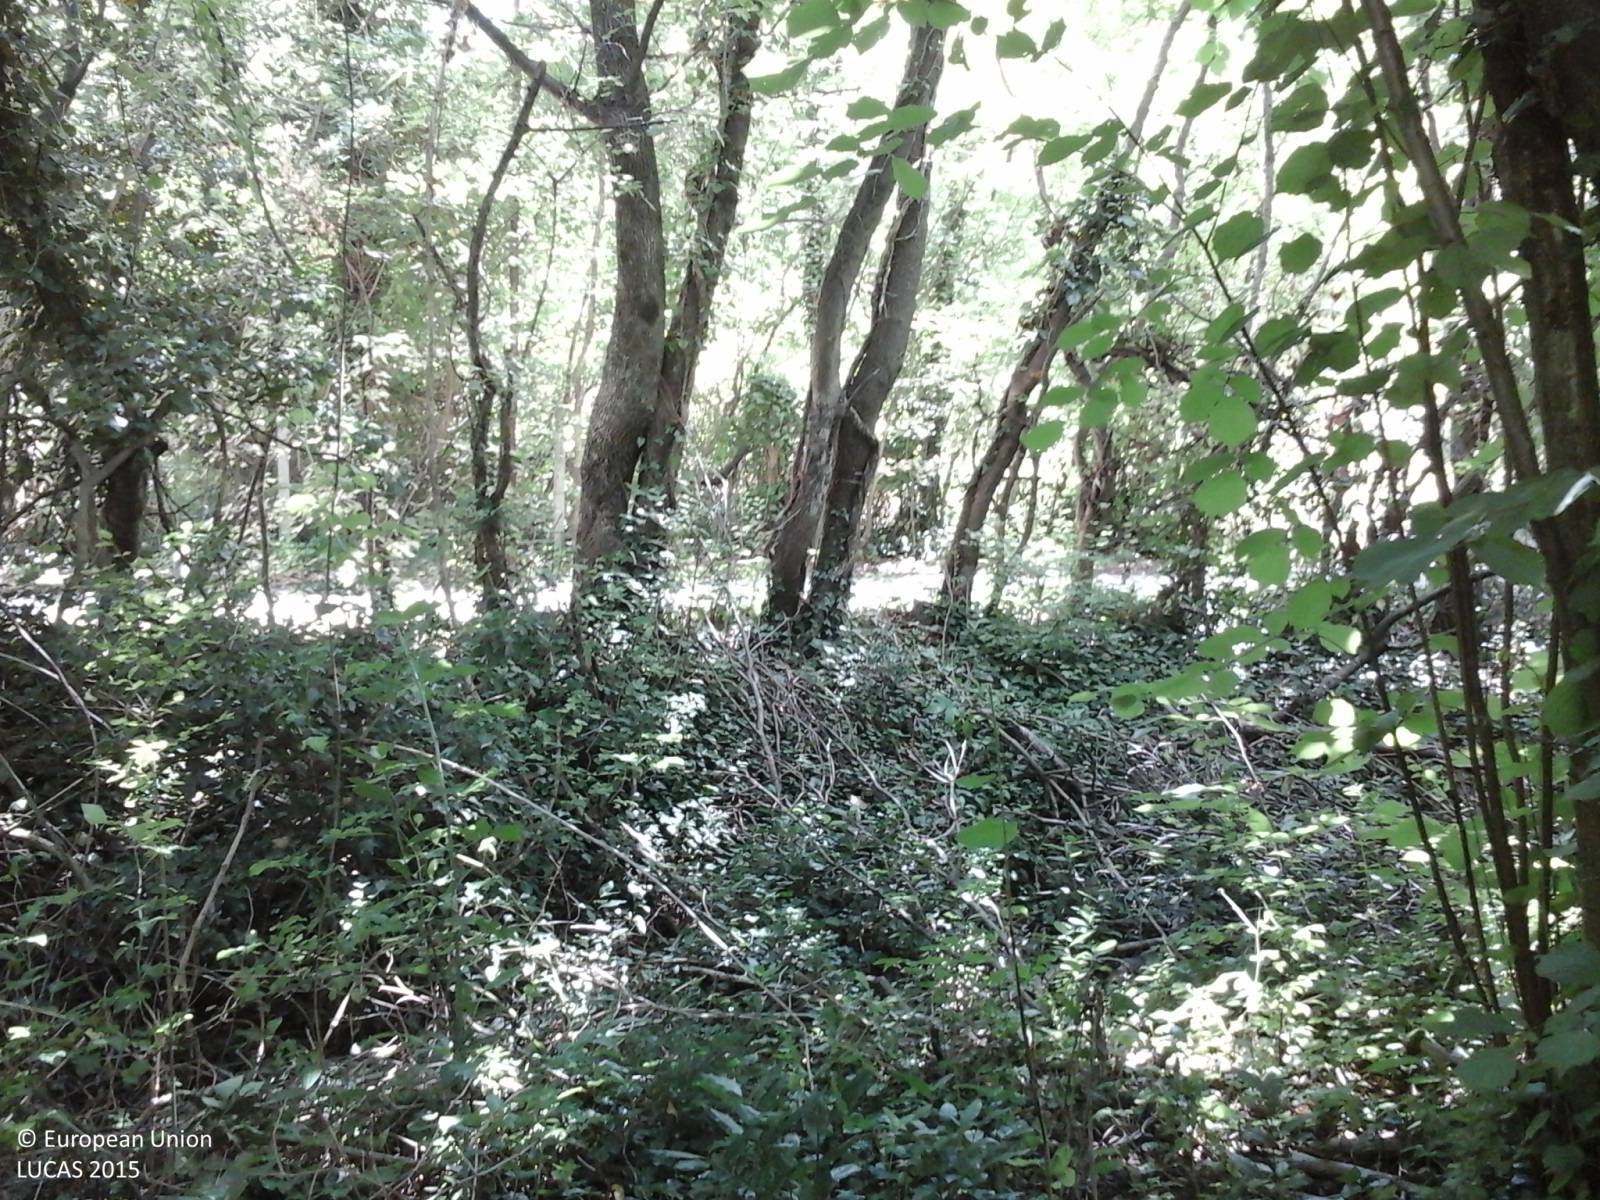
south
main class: Woodland
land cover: Broadleaved woodland
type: thermophilous deciduous forest
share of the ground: > 75 %
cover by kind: broadleaved forest trees 80 %, shrubs 20 %
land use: Semi-natural and natural areas not in use
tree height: > 5 m
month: June
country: IT
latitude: 45.7863
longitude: 13.5846
